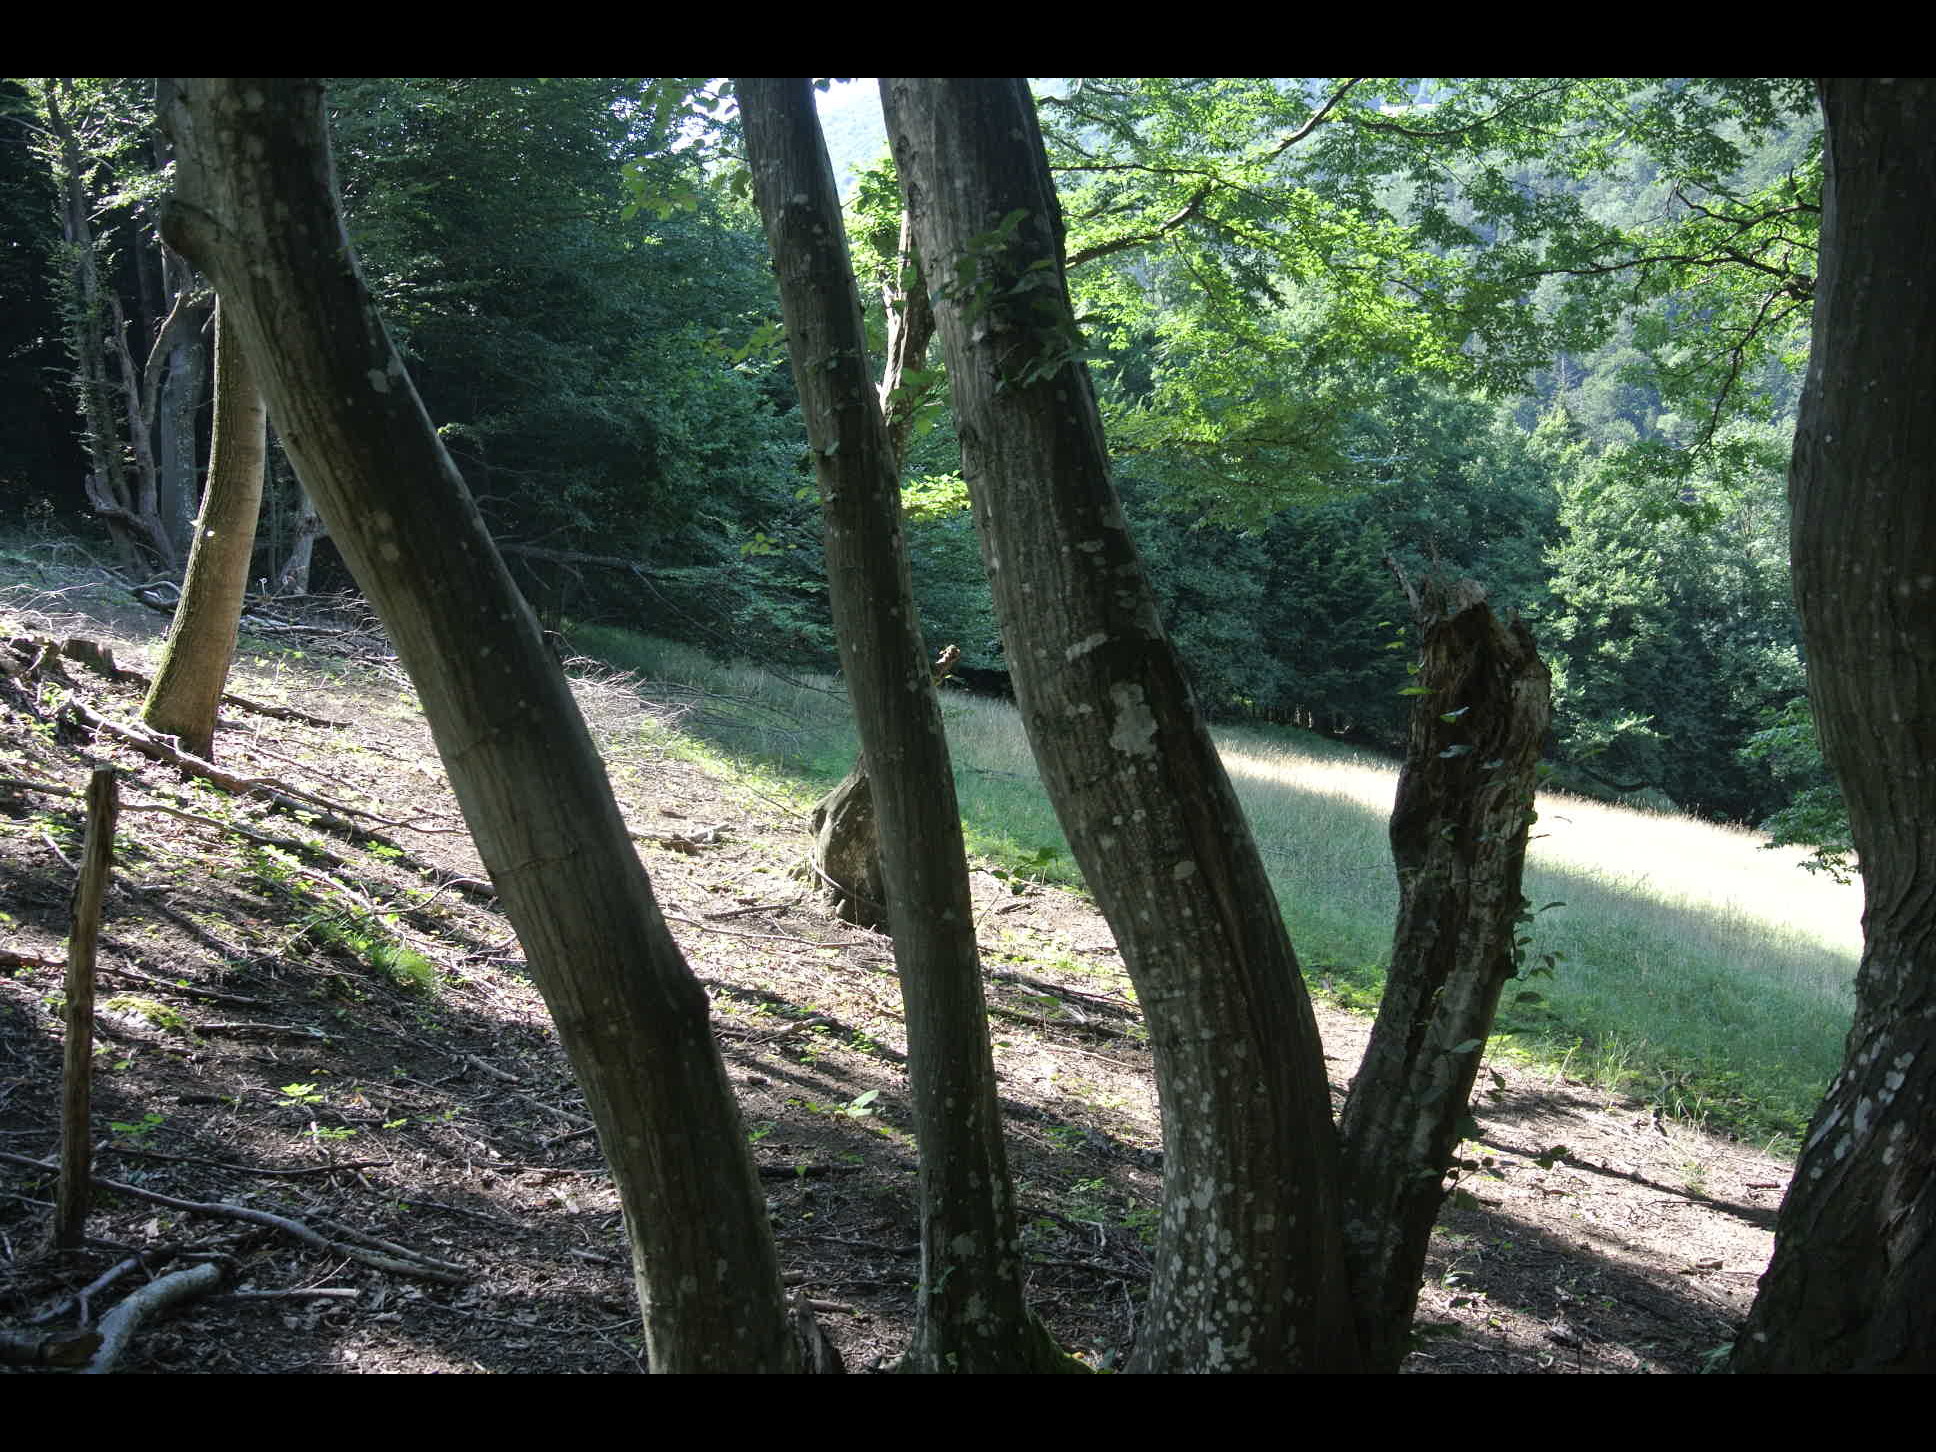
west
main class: Woodland
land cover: Broadleaved woodland
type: alpine coniferous forest
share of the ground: > 75 %
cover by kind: broadleaved forest trees 90 %, unconsolidated bare surface 10 %
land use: Forestry
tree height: > 5 m
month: July
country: AT
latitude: 47.9929
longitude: 15.5634
